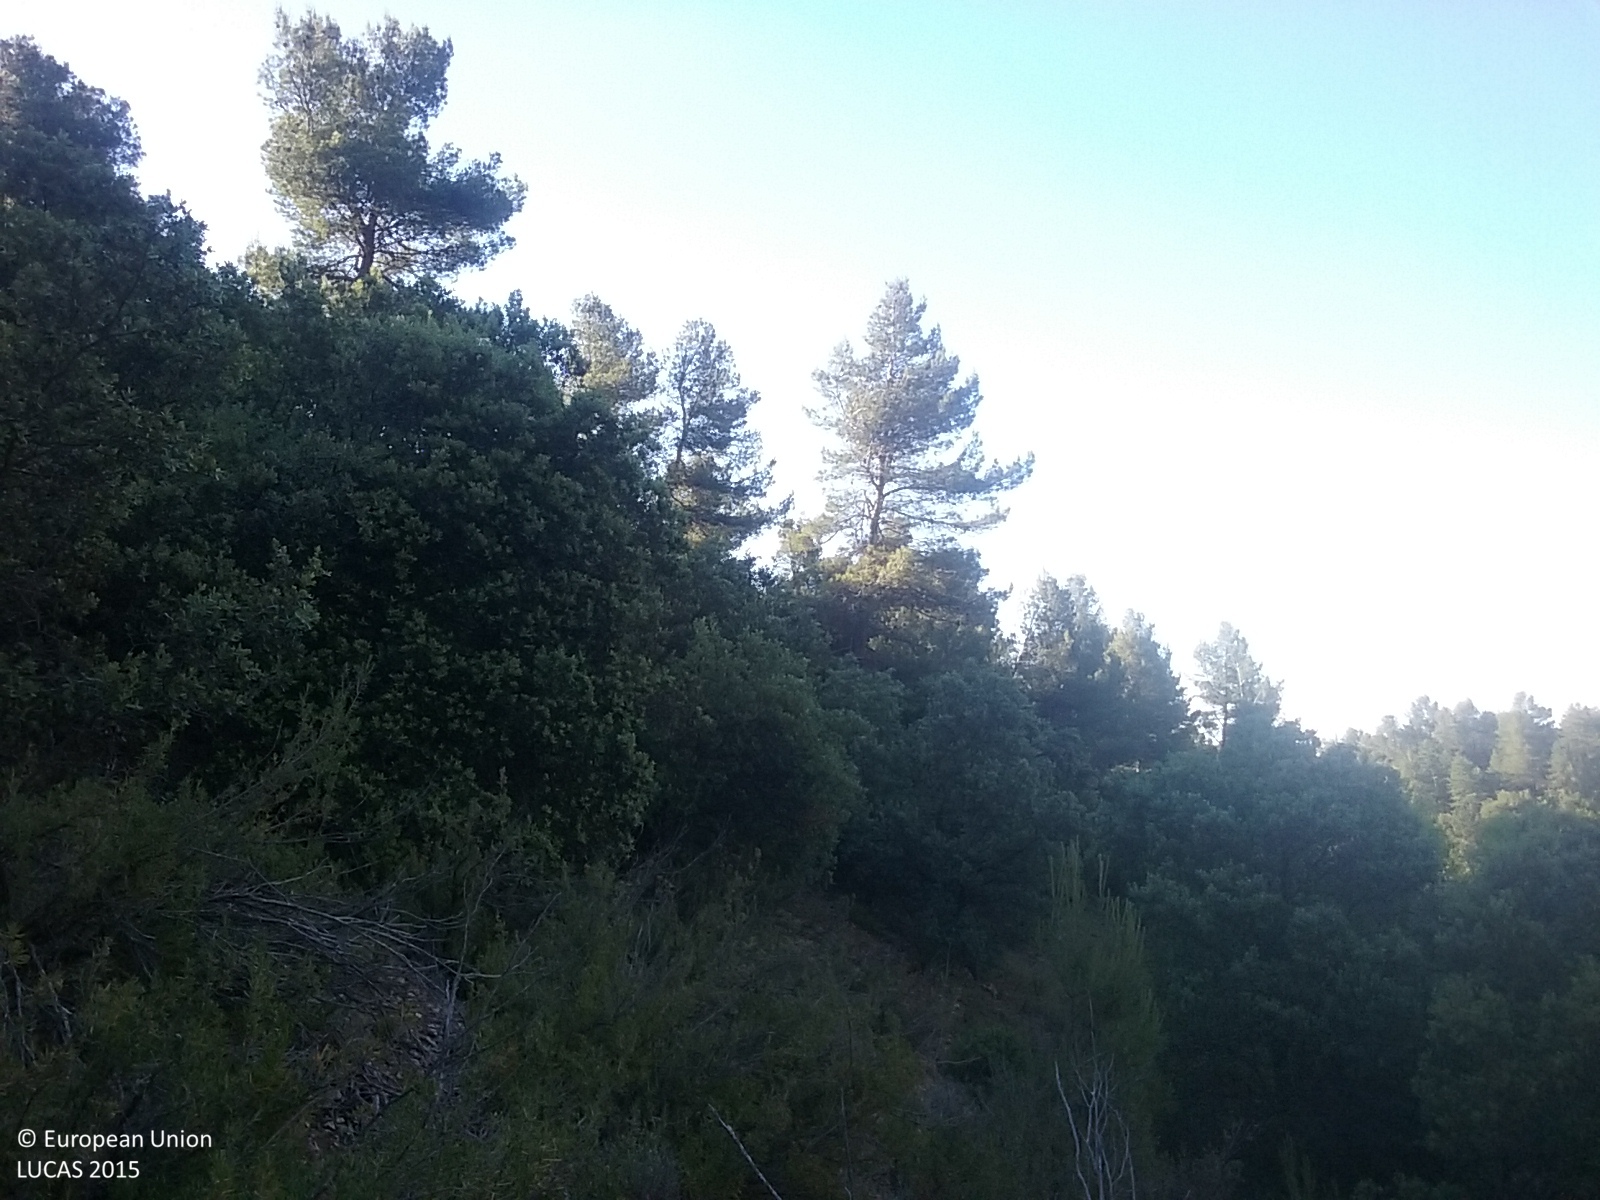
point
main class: Woodland
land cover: Pine dominated mixed woodland
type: coniferous forest of the mediterranean region
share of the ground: > 75 %
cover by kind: coniferous forest trees 50 %, broadleaved forest trees 40 %, shrubs 10 %
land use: Semi-natural and natural areas not in use
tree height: > 5 m
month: June
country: ES
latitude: 40.7301
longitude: -0.0843
